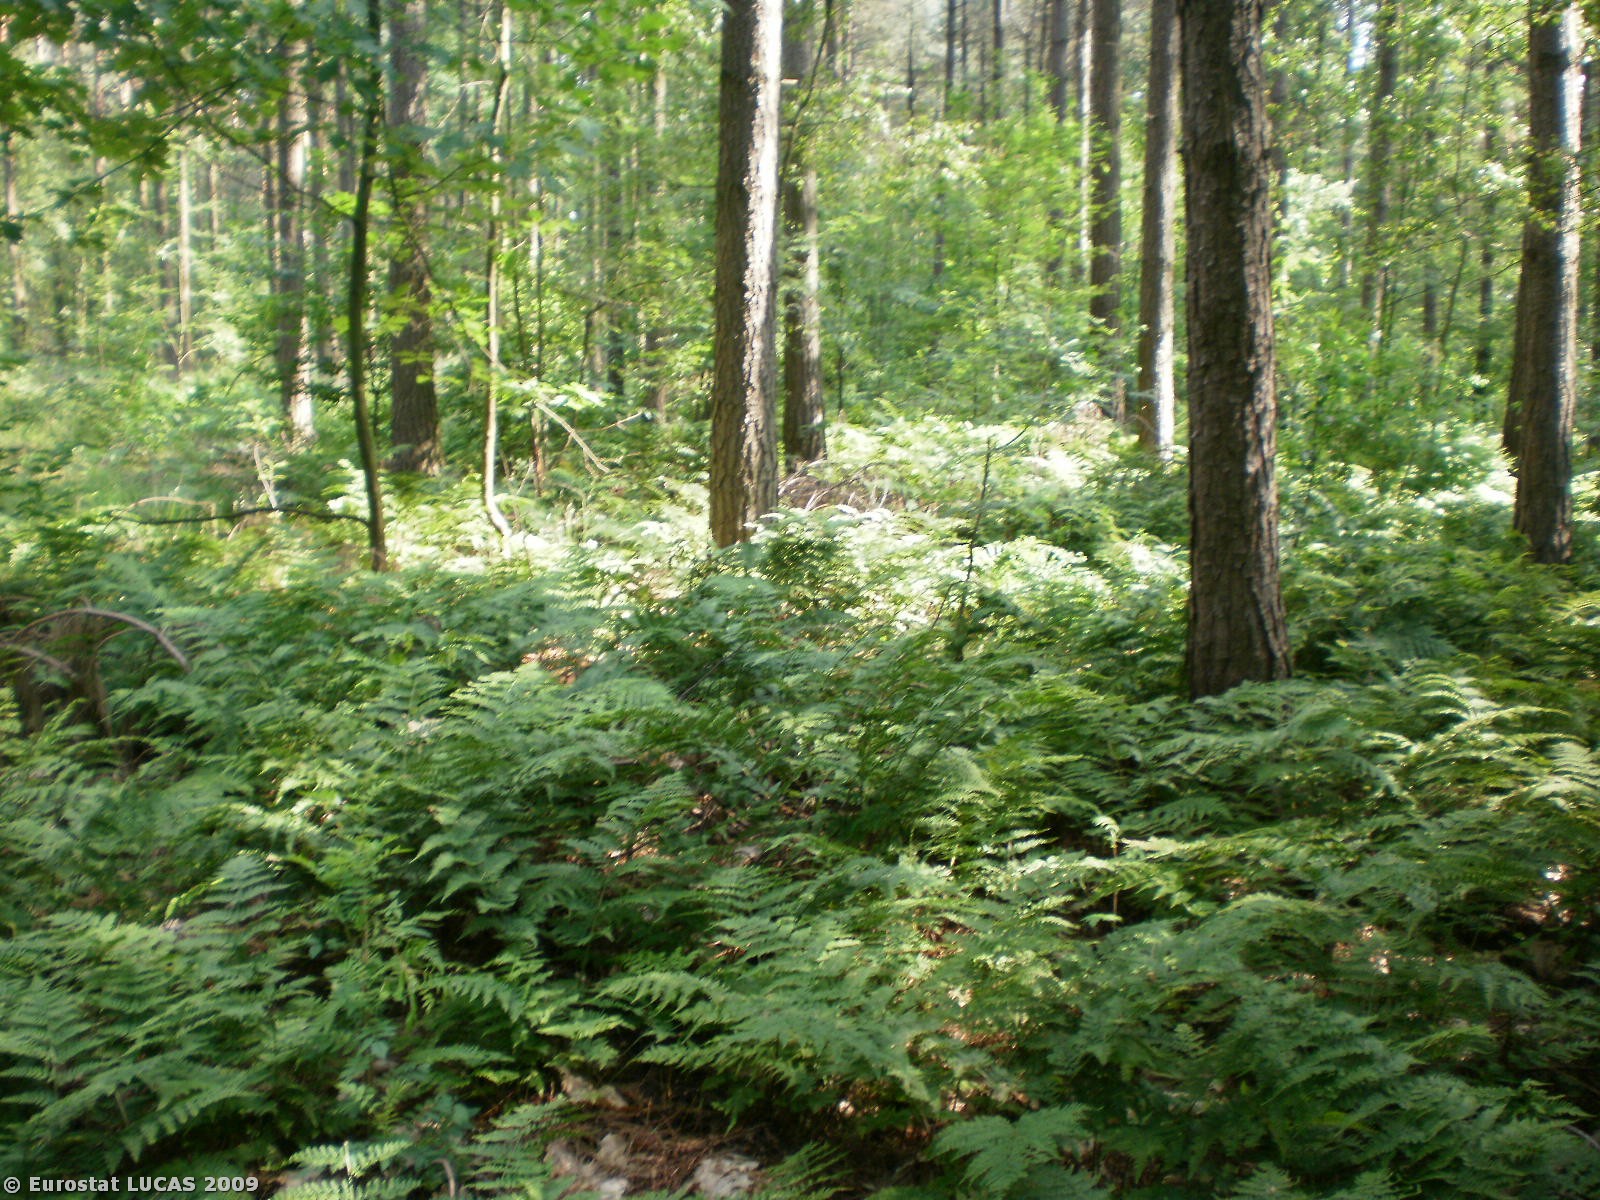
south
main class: Woodland
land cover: Mixed woodland
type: hemiboreal forest and nemoral coniferous forest and mixed broadleaved-coniferous forest
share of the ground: > 75 %
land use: Nature reserves
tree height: > 5 m
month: June
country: BE
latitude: 51.0299
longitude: 5.4495
